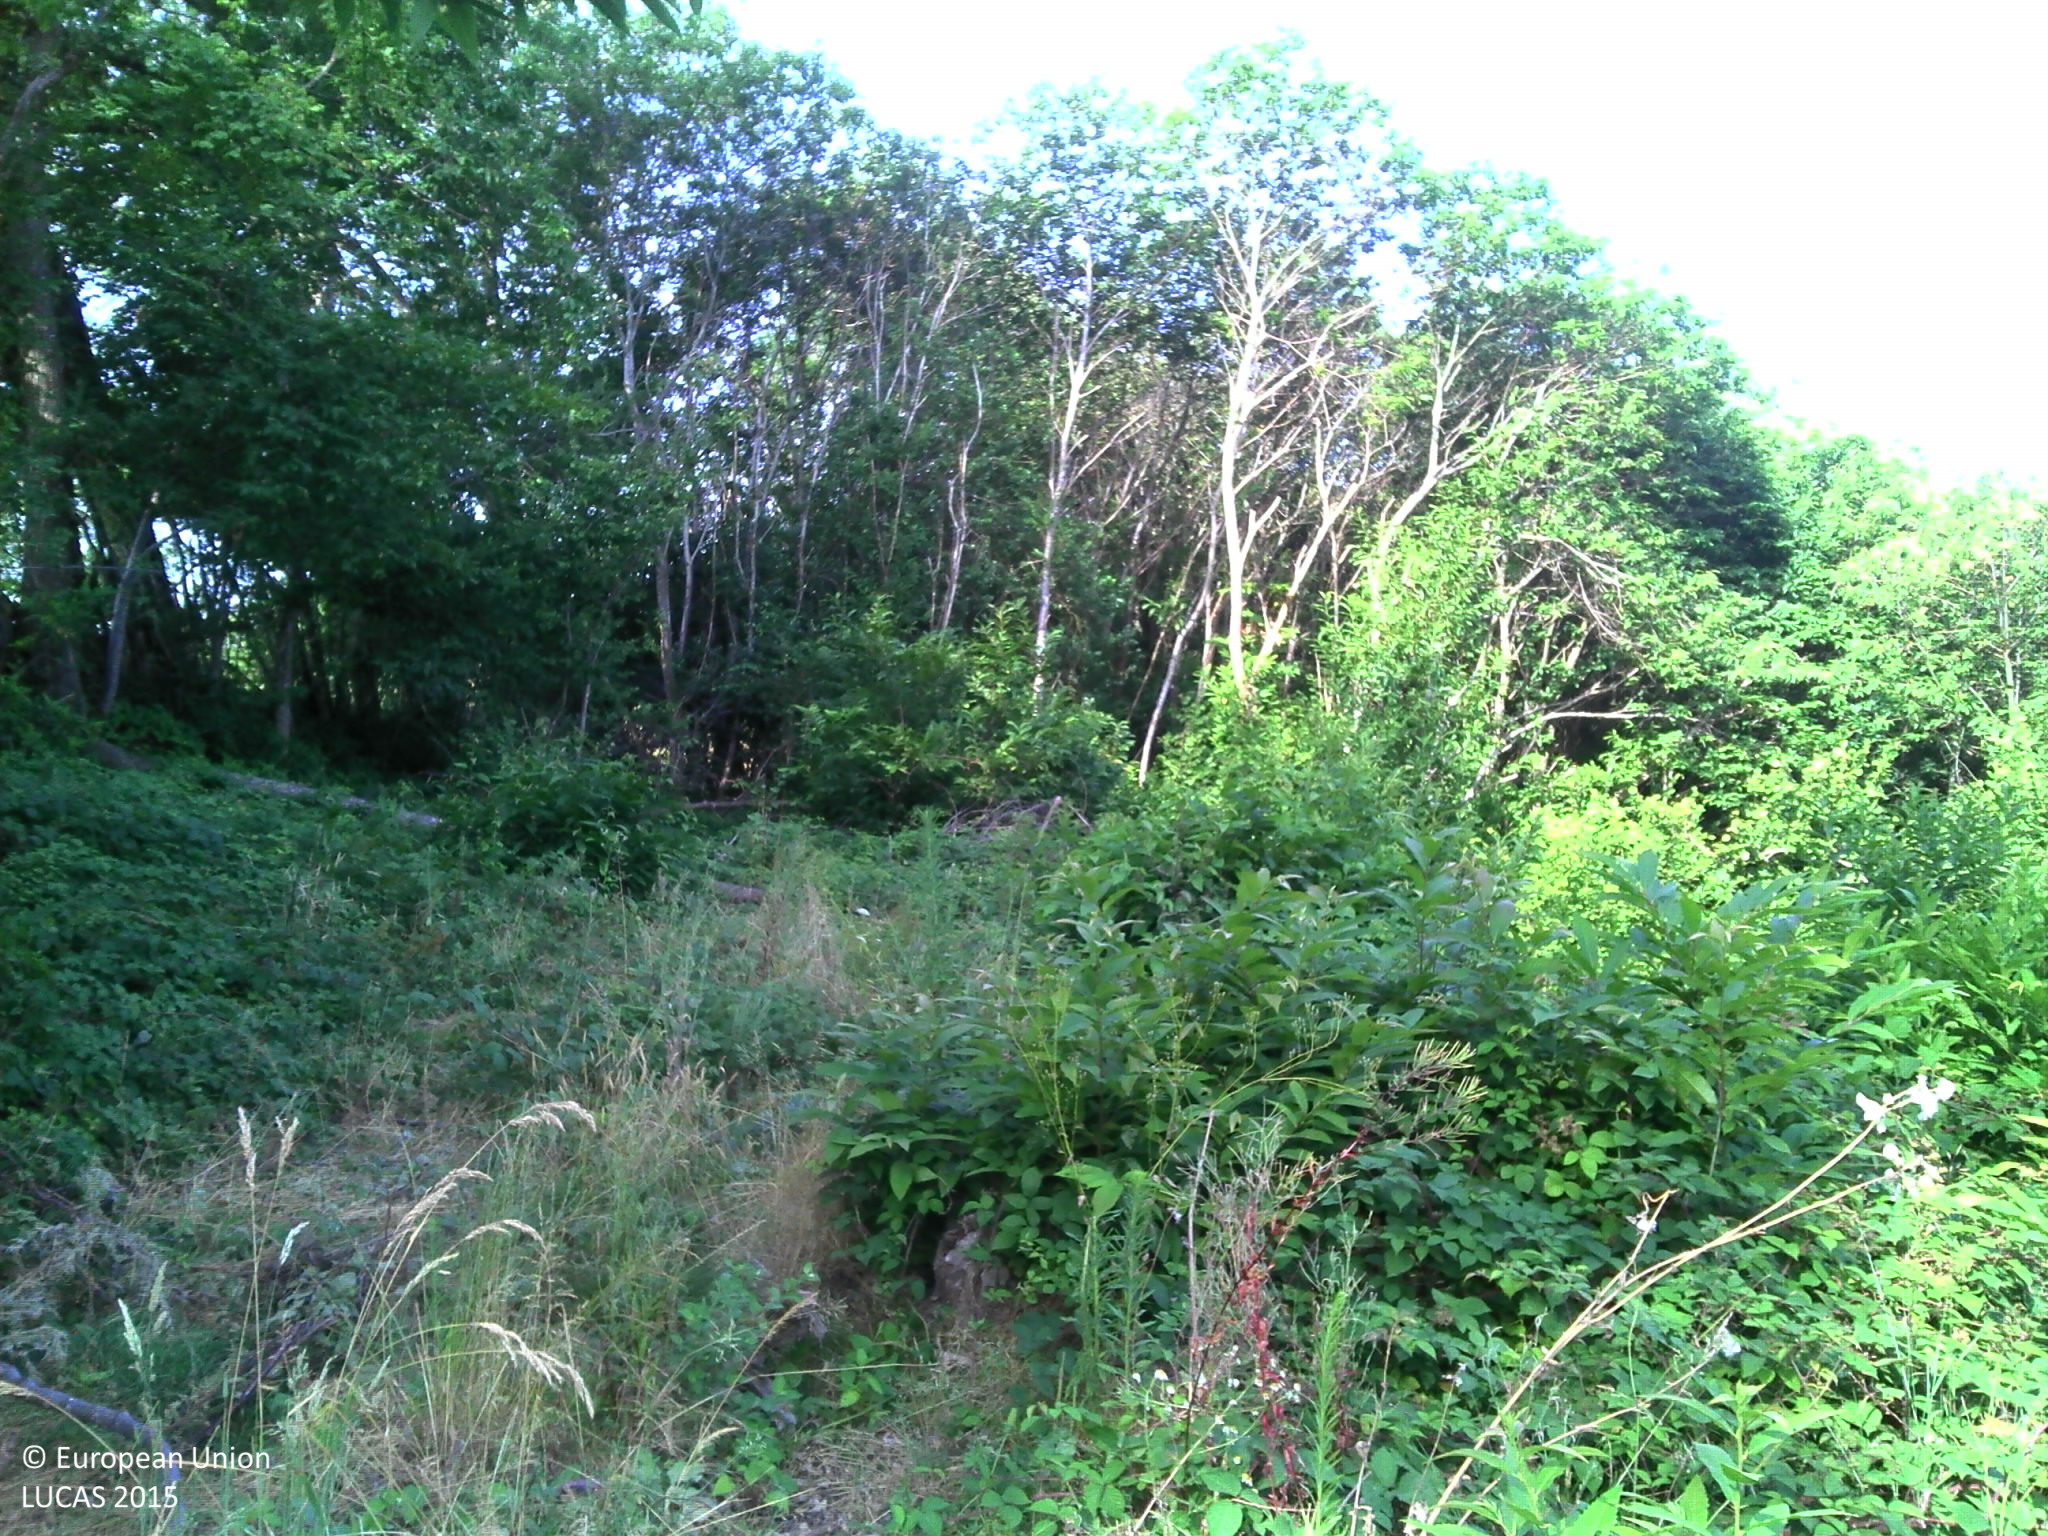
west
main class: Woodland
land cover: Broadleaved woodland
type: floodplain forest
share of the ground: > 75 %
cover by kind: broadleaved forest trees 50 %, herbaceous plants 50 %
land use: Forestry
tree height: > 5 m
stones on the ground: 10 - 25 %
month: July
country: FR
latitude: 45.4960
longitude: 5.4362
